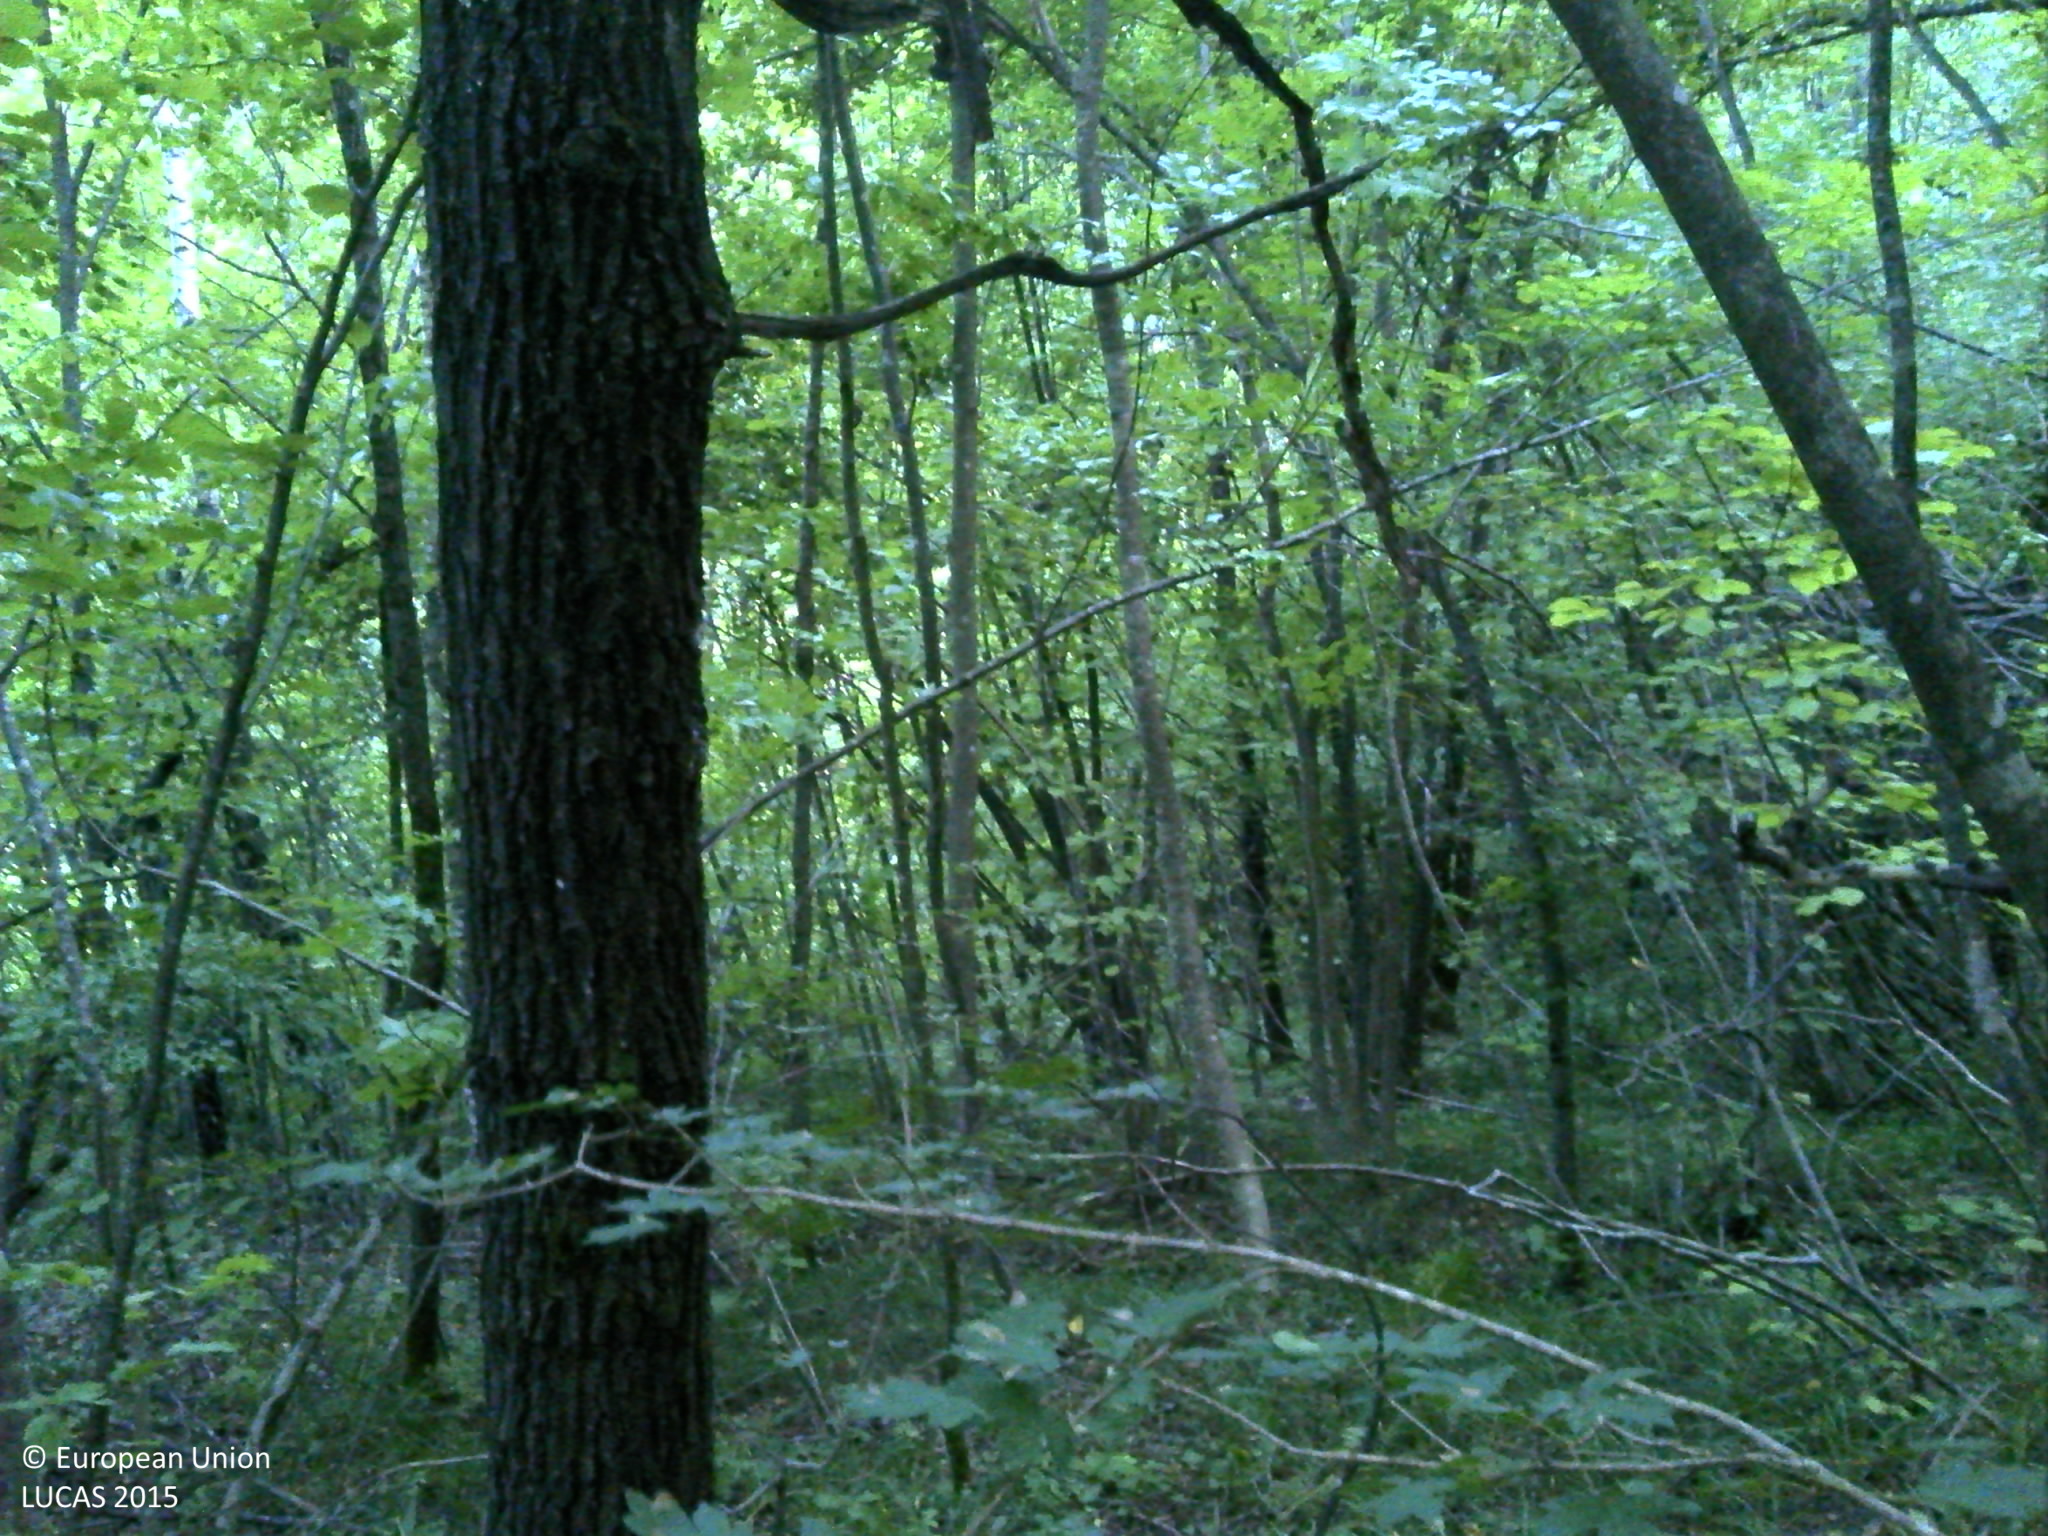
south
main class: Woodland
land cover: Broadleaved woodland
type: beech forest
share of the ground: > 75 %
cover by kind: broadleaved forest trees 100 %
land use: Forestry
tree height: > 5 m
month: August
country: HR
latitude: 45.2852
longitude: 16.5124
